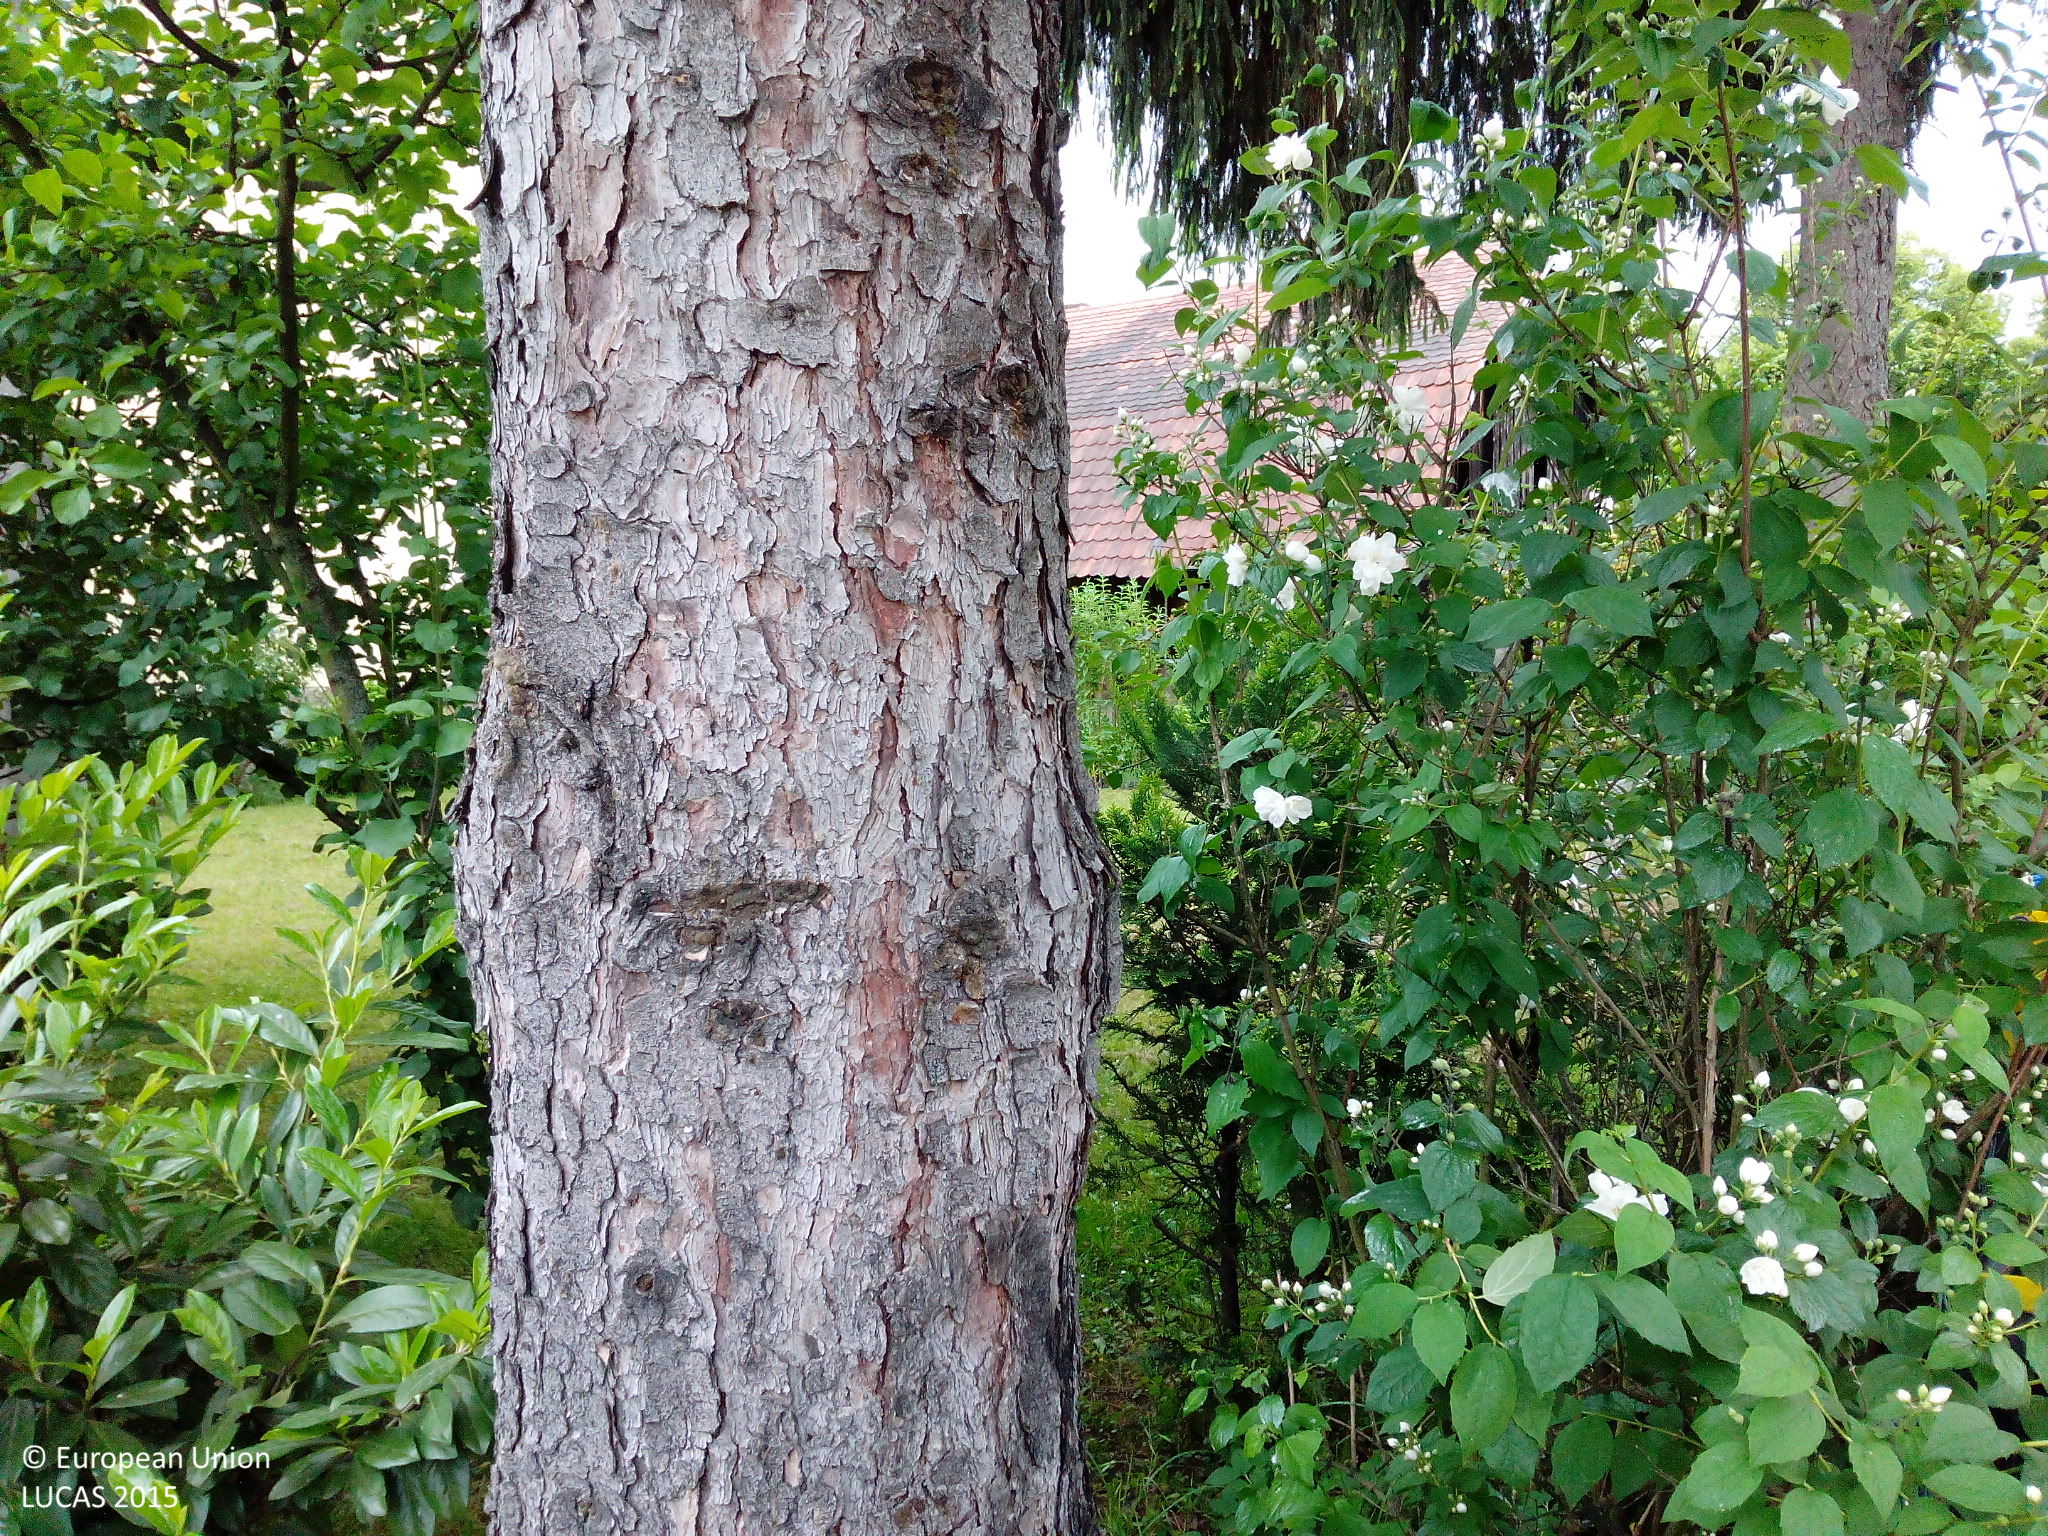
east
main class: Grassland
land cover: Grassland without tree/shrub cover
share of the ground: > 75 %
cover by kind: herbaceous plants 90 %, unconsolidated bare surface 10 %
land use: Residential
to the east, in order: Grassland without tree/shrub cover; Artificial constructions in urban areas
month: May
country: DE
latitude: 48.7846
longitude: 8.1905
